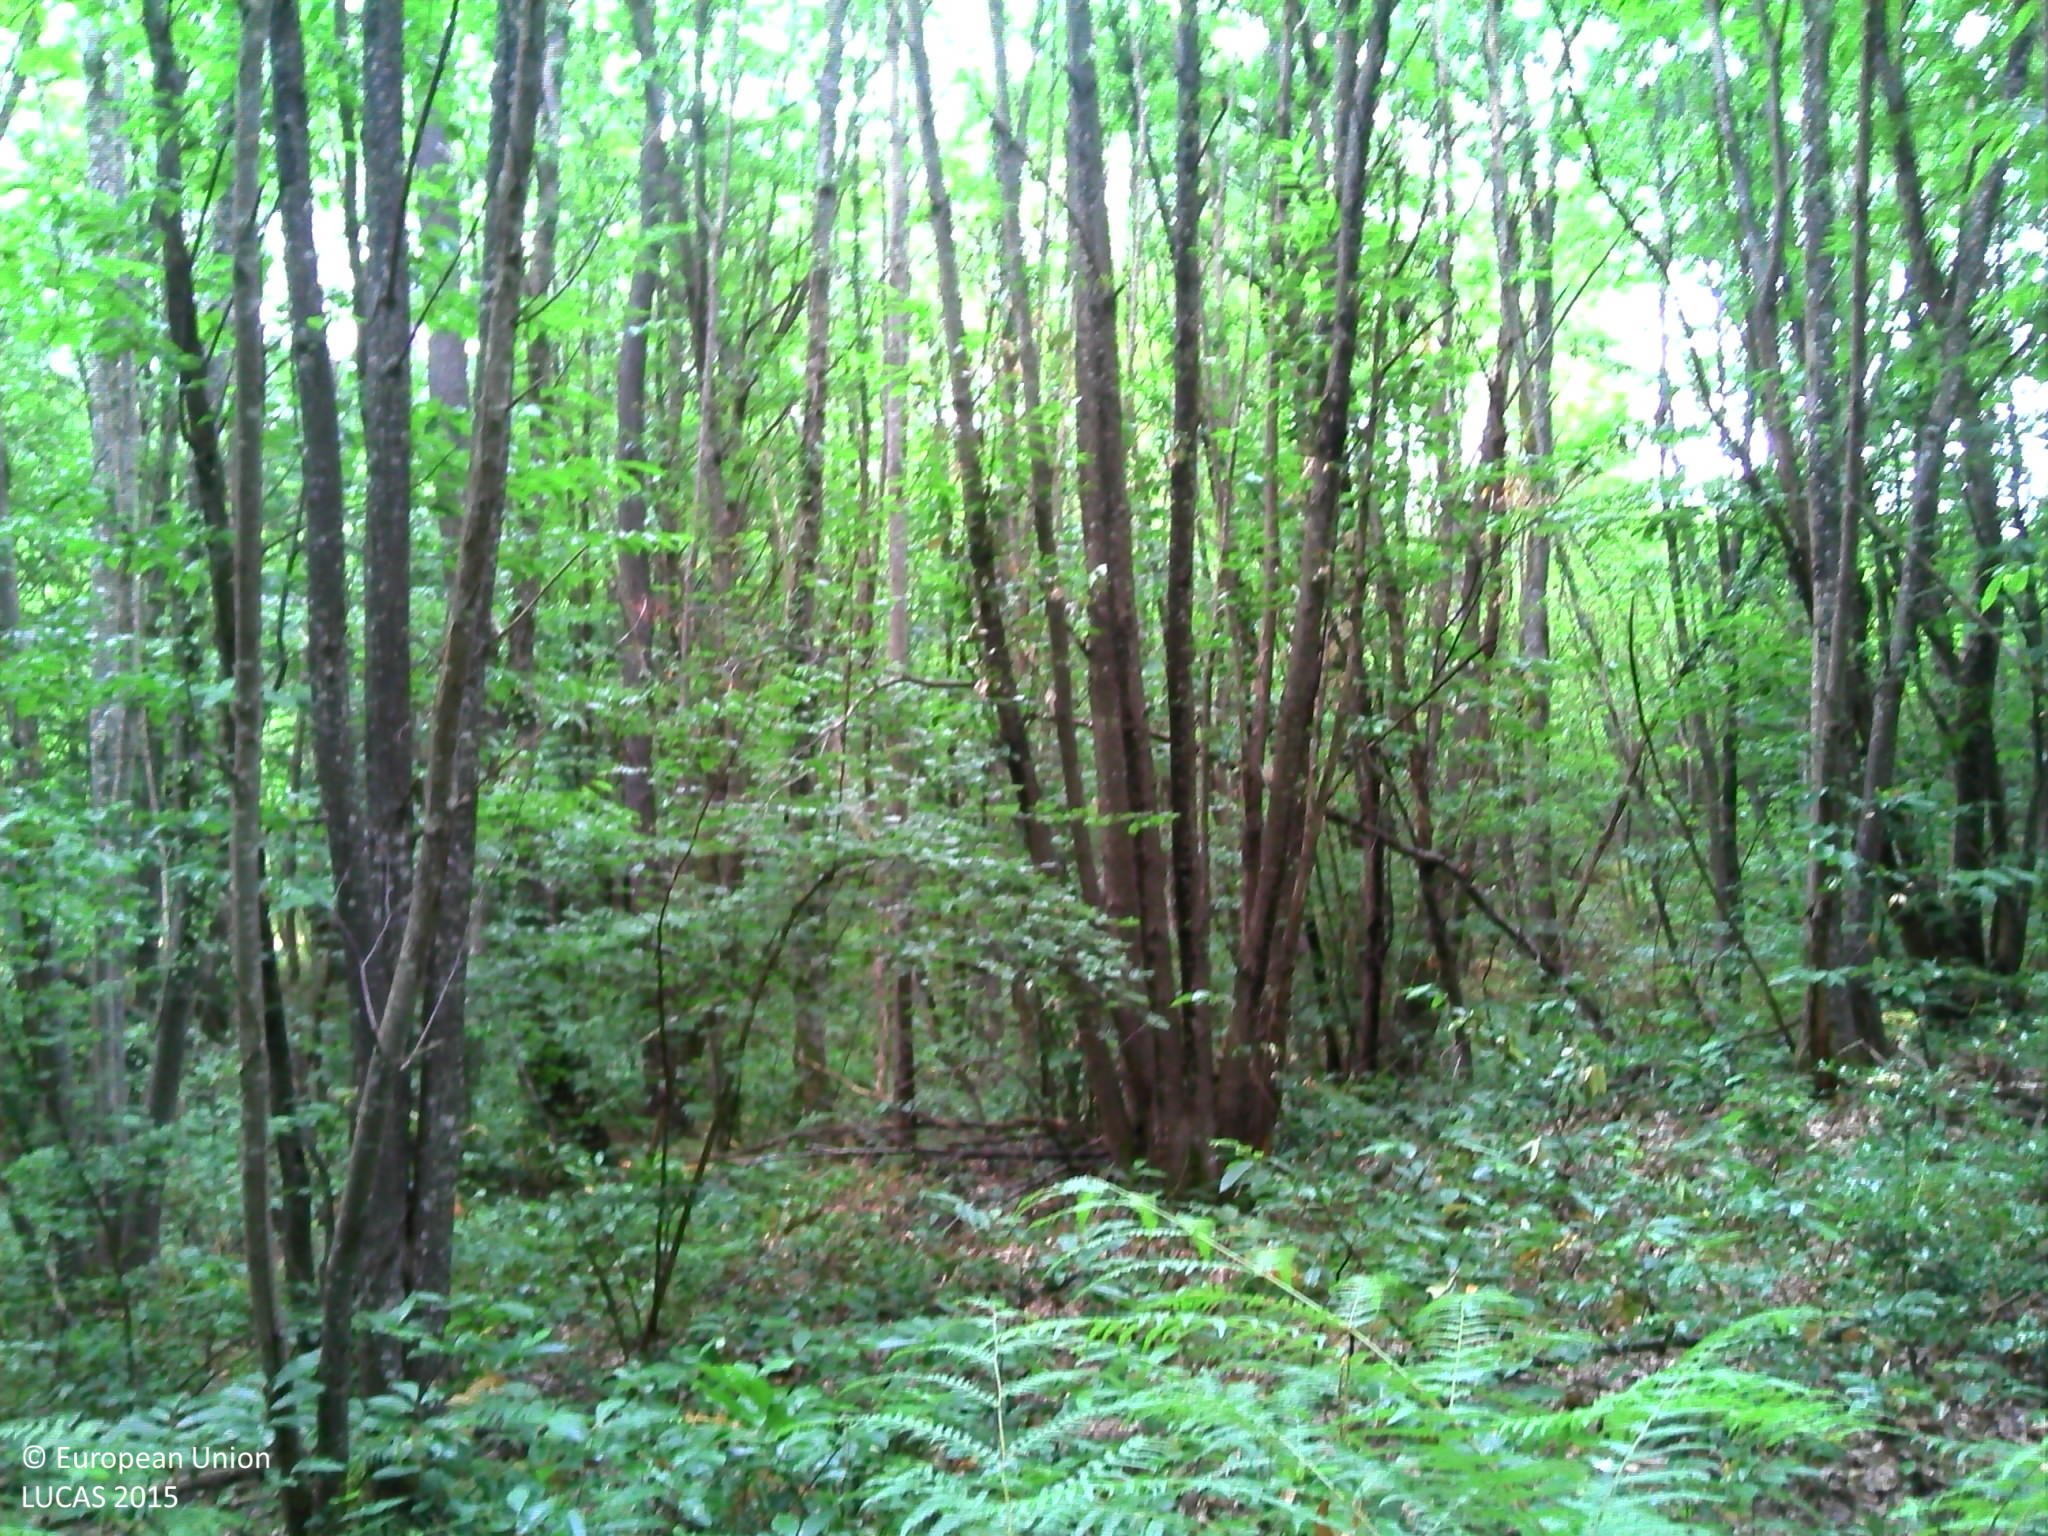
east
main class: Woodland
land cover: Broadleaved woodland
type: thermophilous deciduous forest
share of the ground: > 75 %
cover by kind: broadleaved forest trees 80 %, herbaceous plants 10 %, shrubs 5 %, lichens and mosses 5 %
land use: Forestry
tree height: > 5 m
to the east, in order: Broadleaved woodland; Tracks; Broadleaved woodland
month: August
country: FR
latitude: 44.6553
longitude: 0.8765
